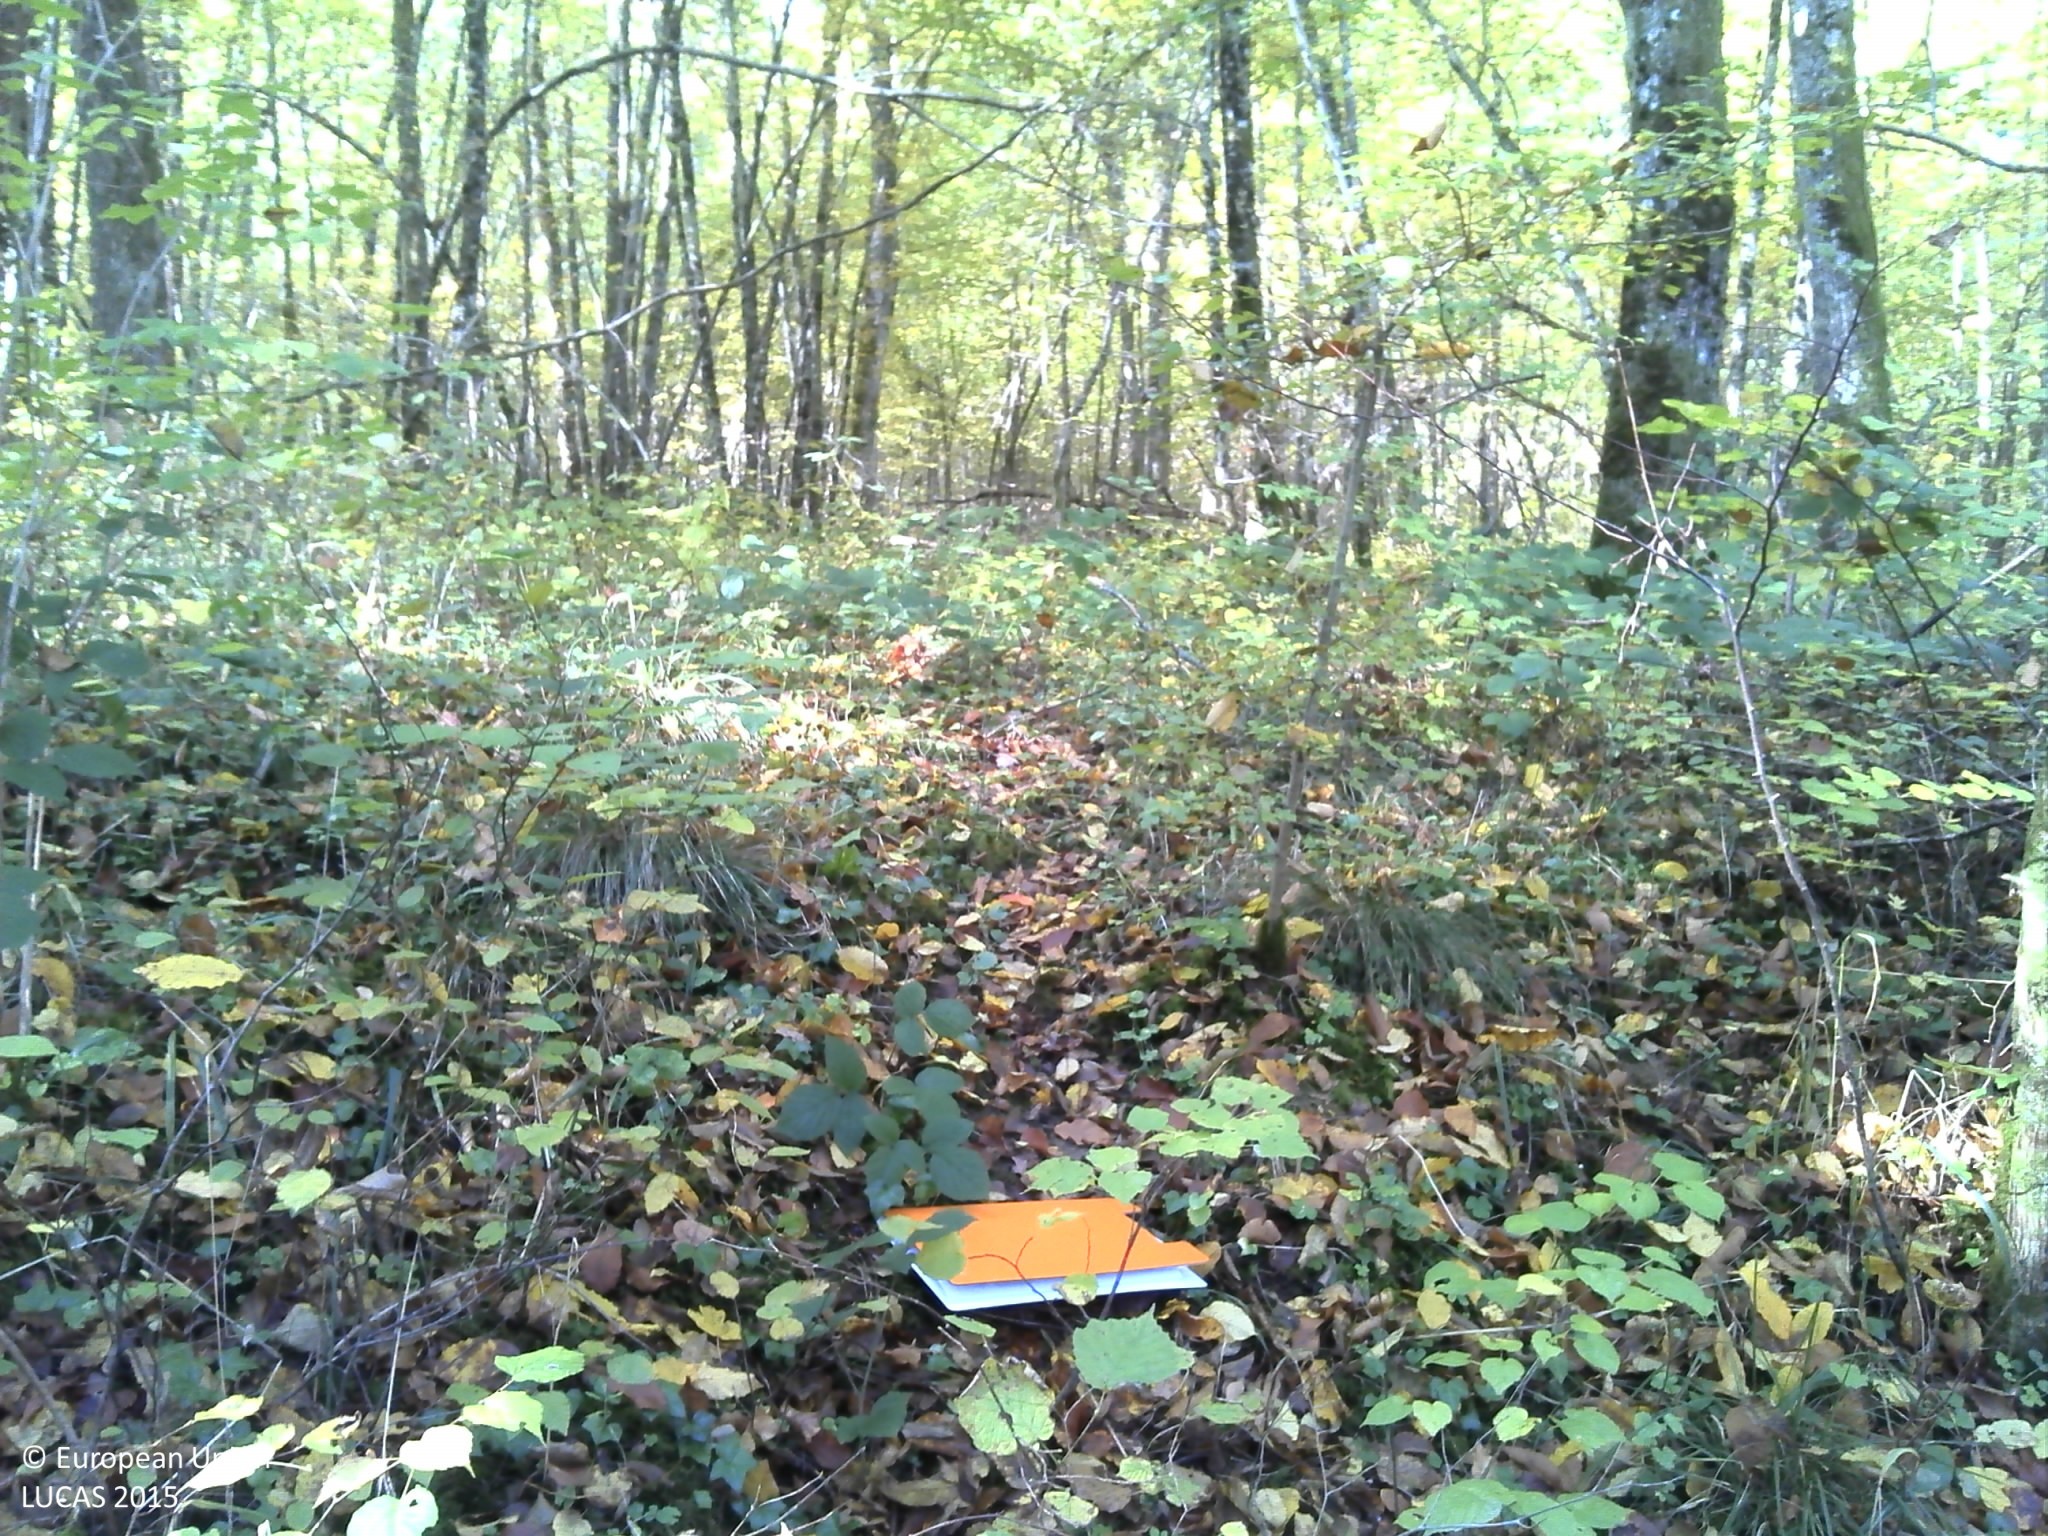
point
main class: Woodland
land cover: Broadleaved woodland
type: mesophytic deciduous forest
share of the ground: > 75 %
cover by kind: broadleaved forest trees 90 %, lichens and mosses 5 %, unconsolidated bare surface 5 %
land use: Forestry
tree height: > 5 m
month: October
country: FR
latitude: 45.8916
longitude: 5.4030
